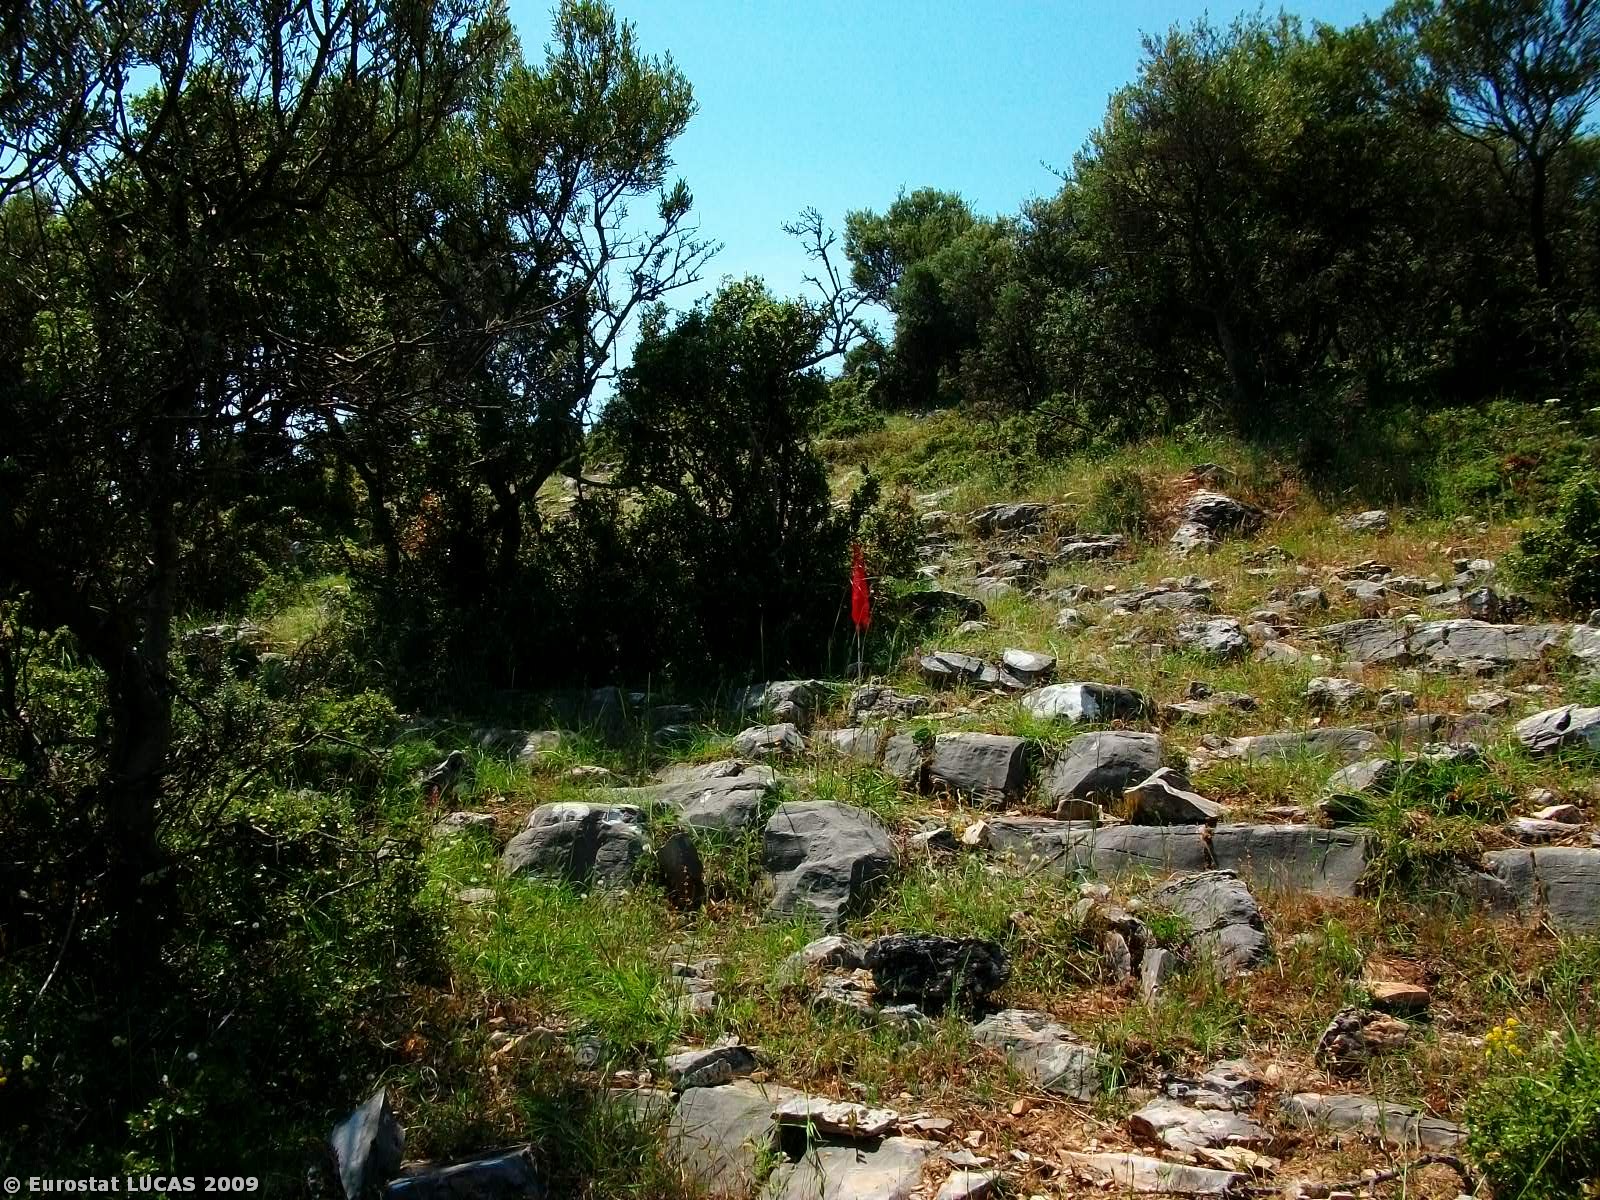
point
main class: Shrubland
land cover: Shrubland with sparse tree cover
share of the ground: 50 - 75 %
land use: Agriculture (excluding fallow land and kitchen gardens)
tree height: < 5 m
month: May
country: GR
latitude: 41.0343
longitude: 24.3886
